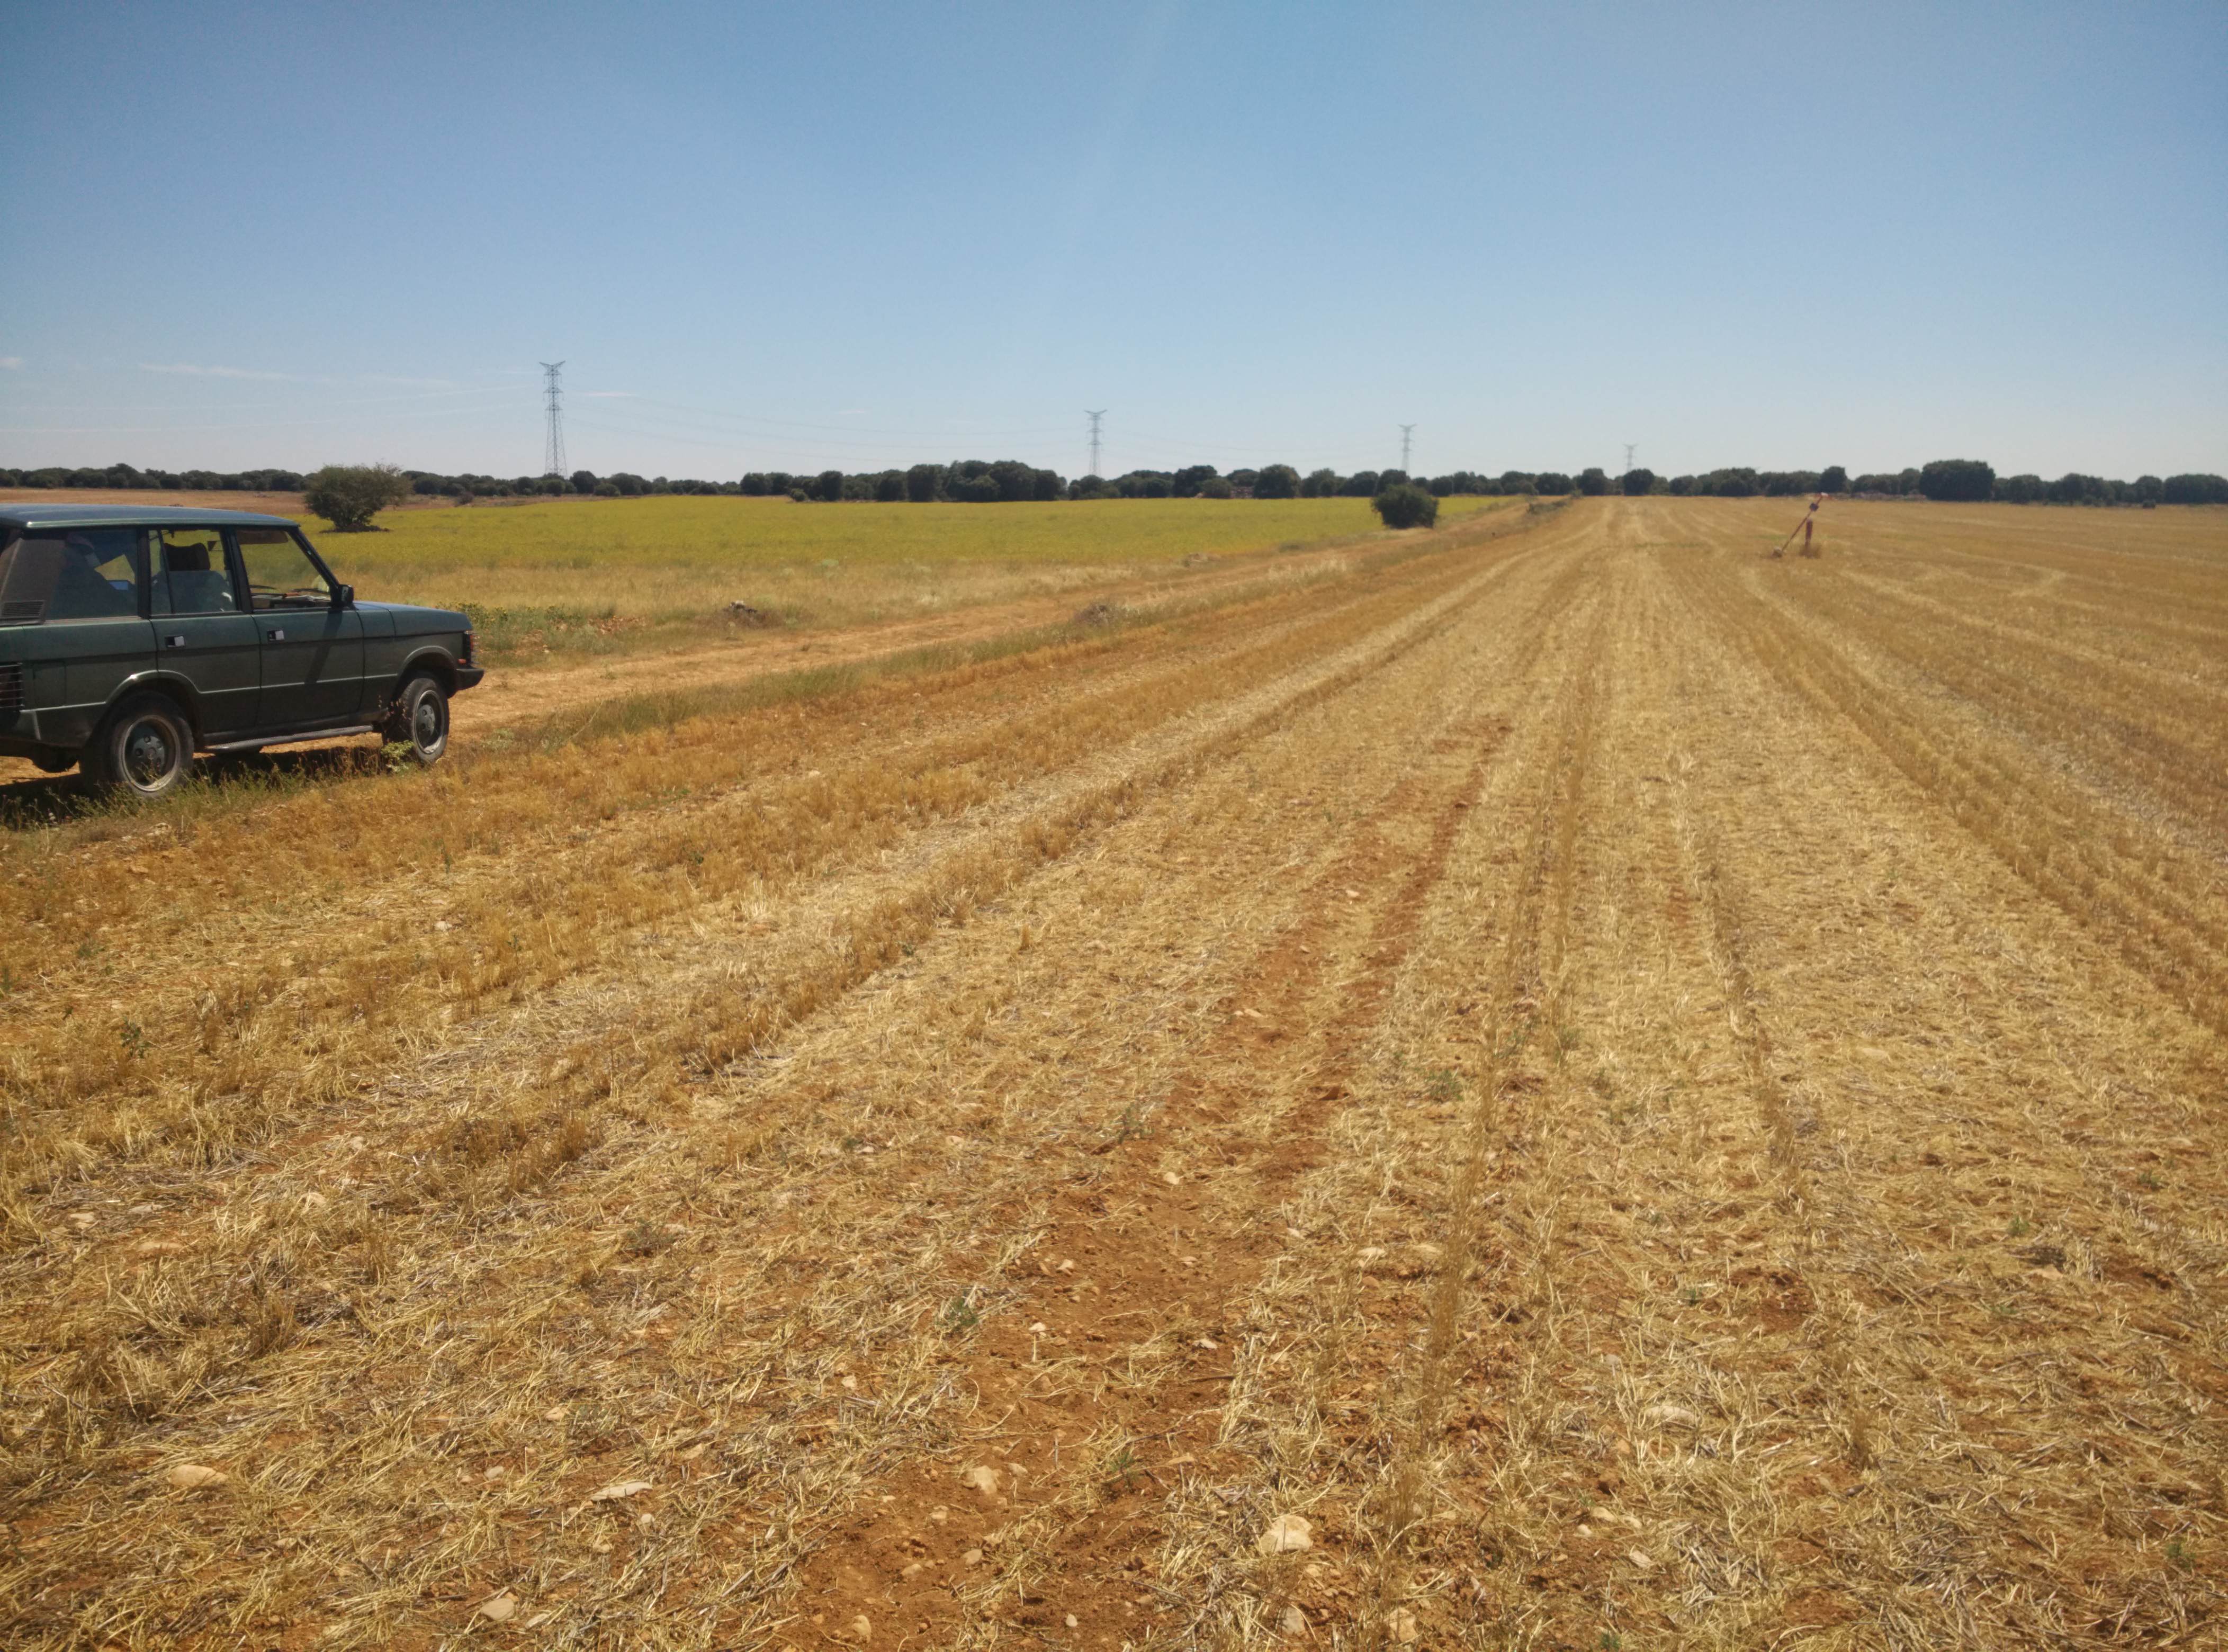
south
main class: Cropland
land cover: Dry pulses
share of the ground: < 10 %
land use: Agriculture (excluding fallow land and kitchen gardens)
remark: Harvested field
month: July
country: ES
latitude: 40.9401
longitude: -2.6812
